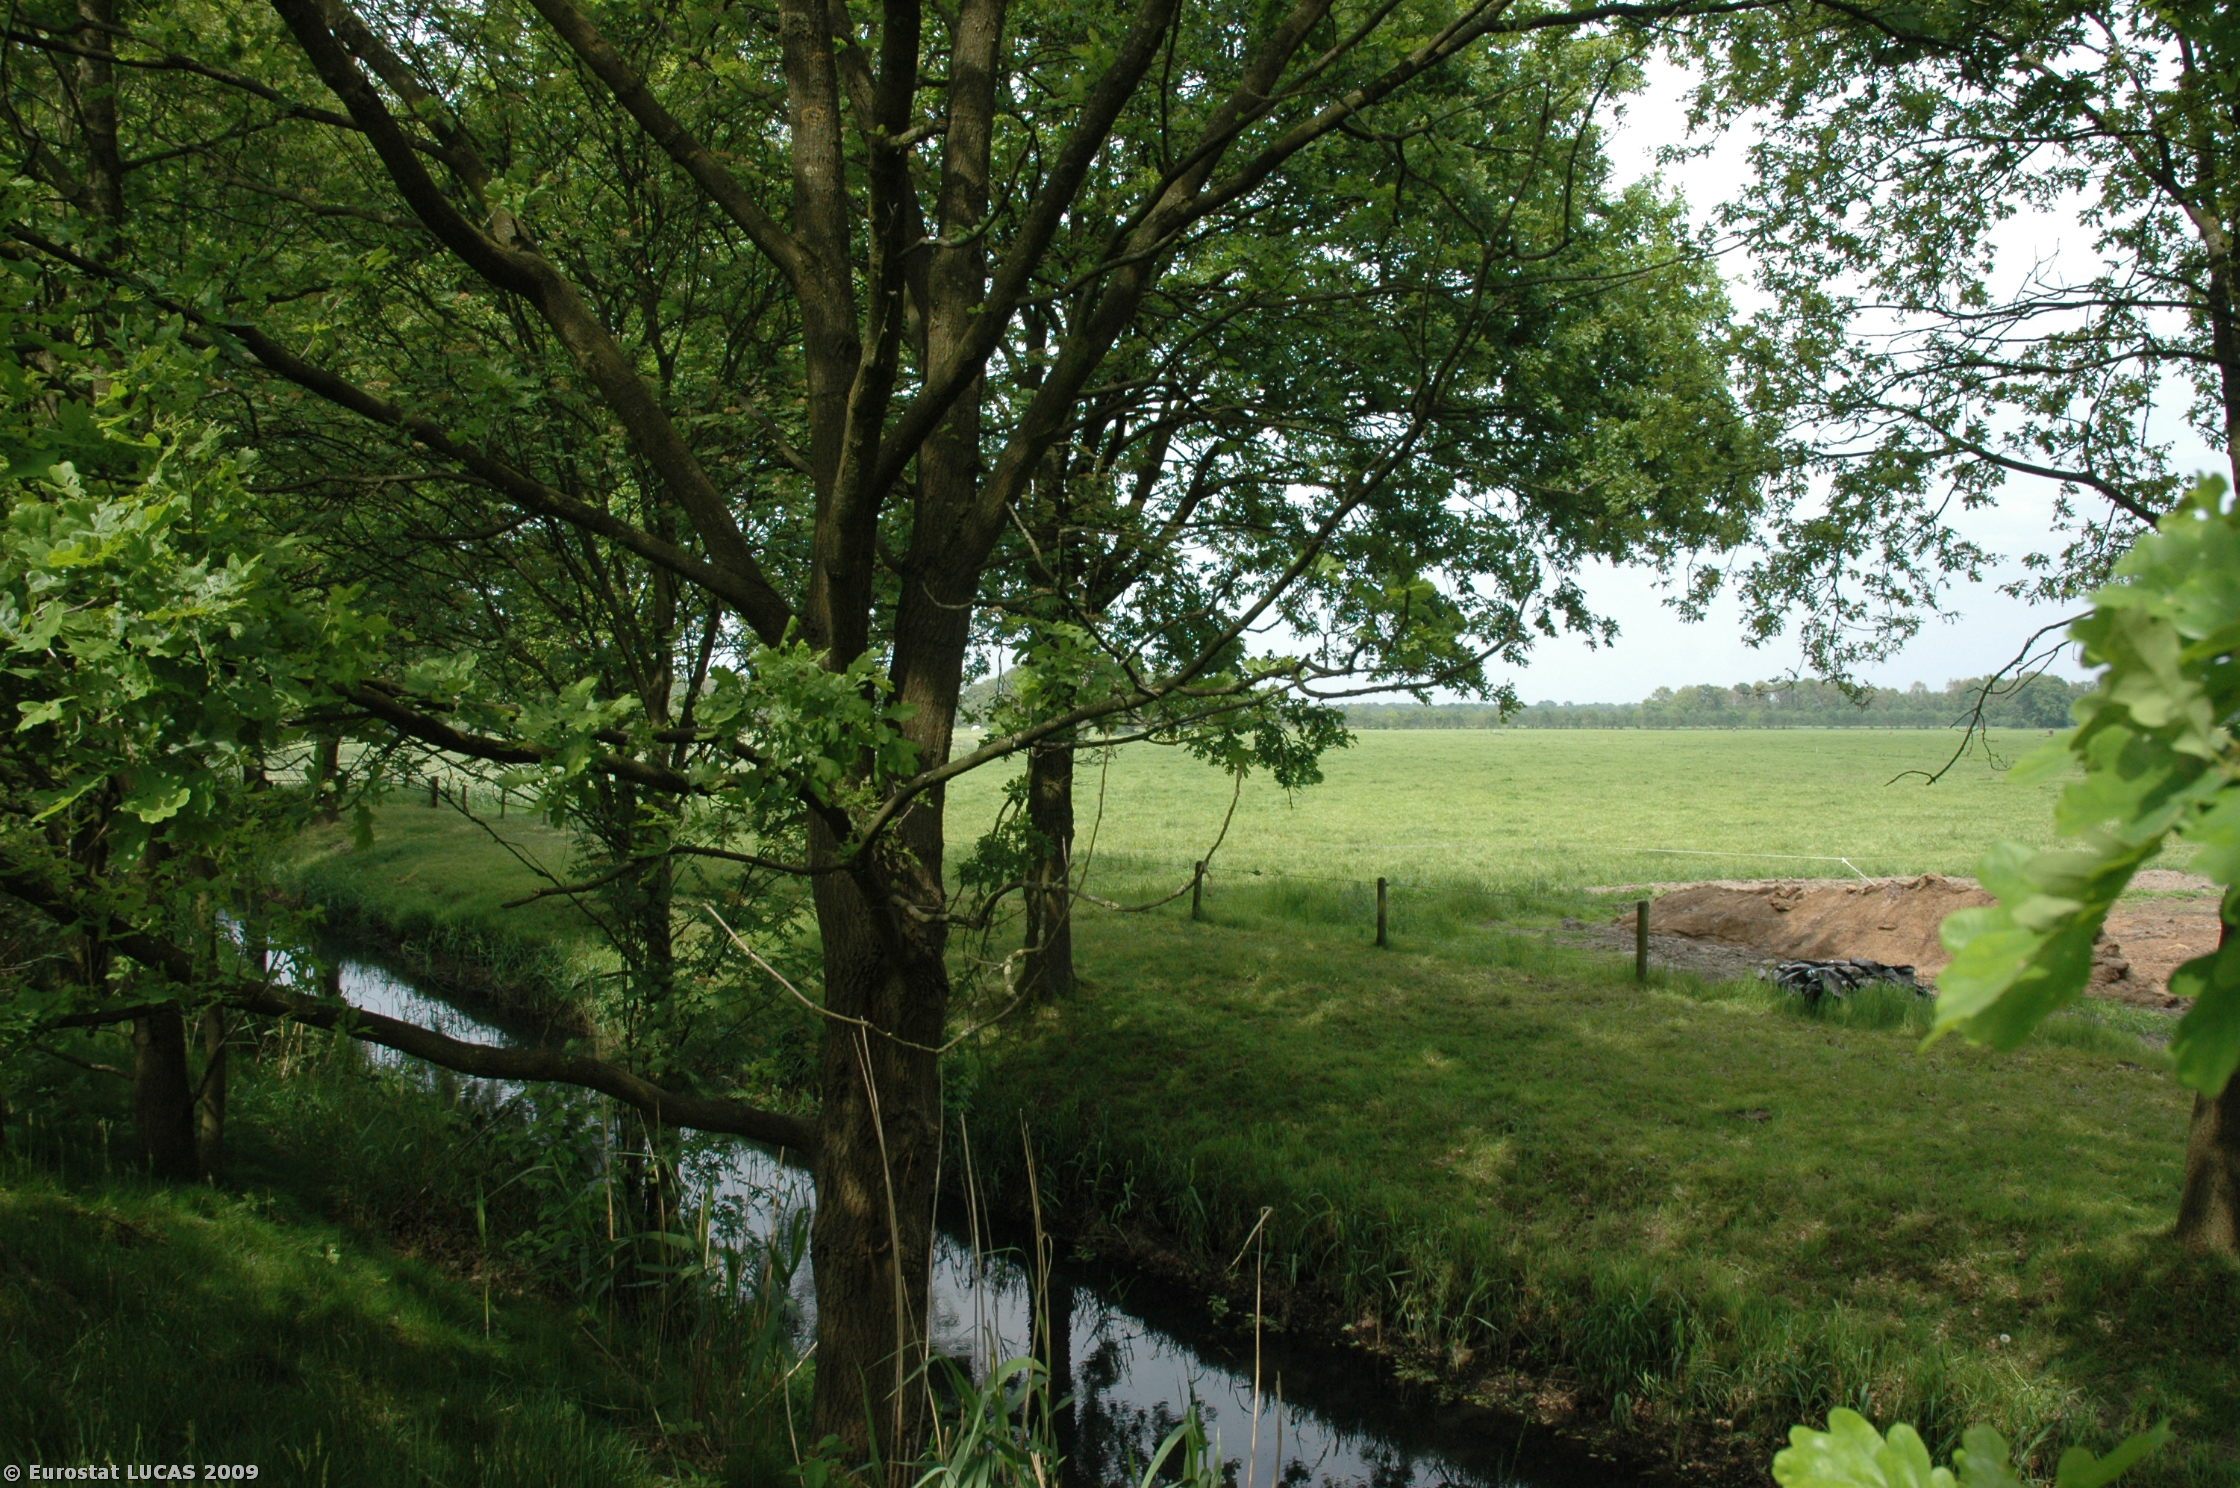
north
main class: Grassland
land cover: Grassland without tree/shrub cover
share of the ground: > 75 %
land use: Agriculture (excluding fallow land and kitchen gardens)
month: May
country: NL
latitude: 52.1094
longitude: 5.4279
